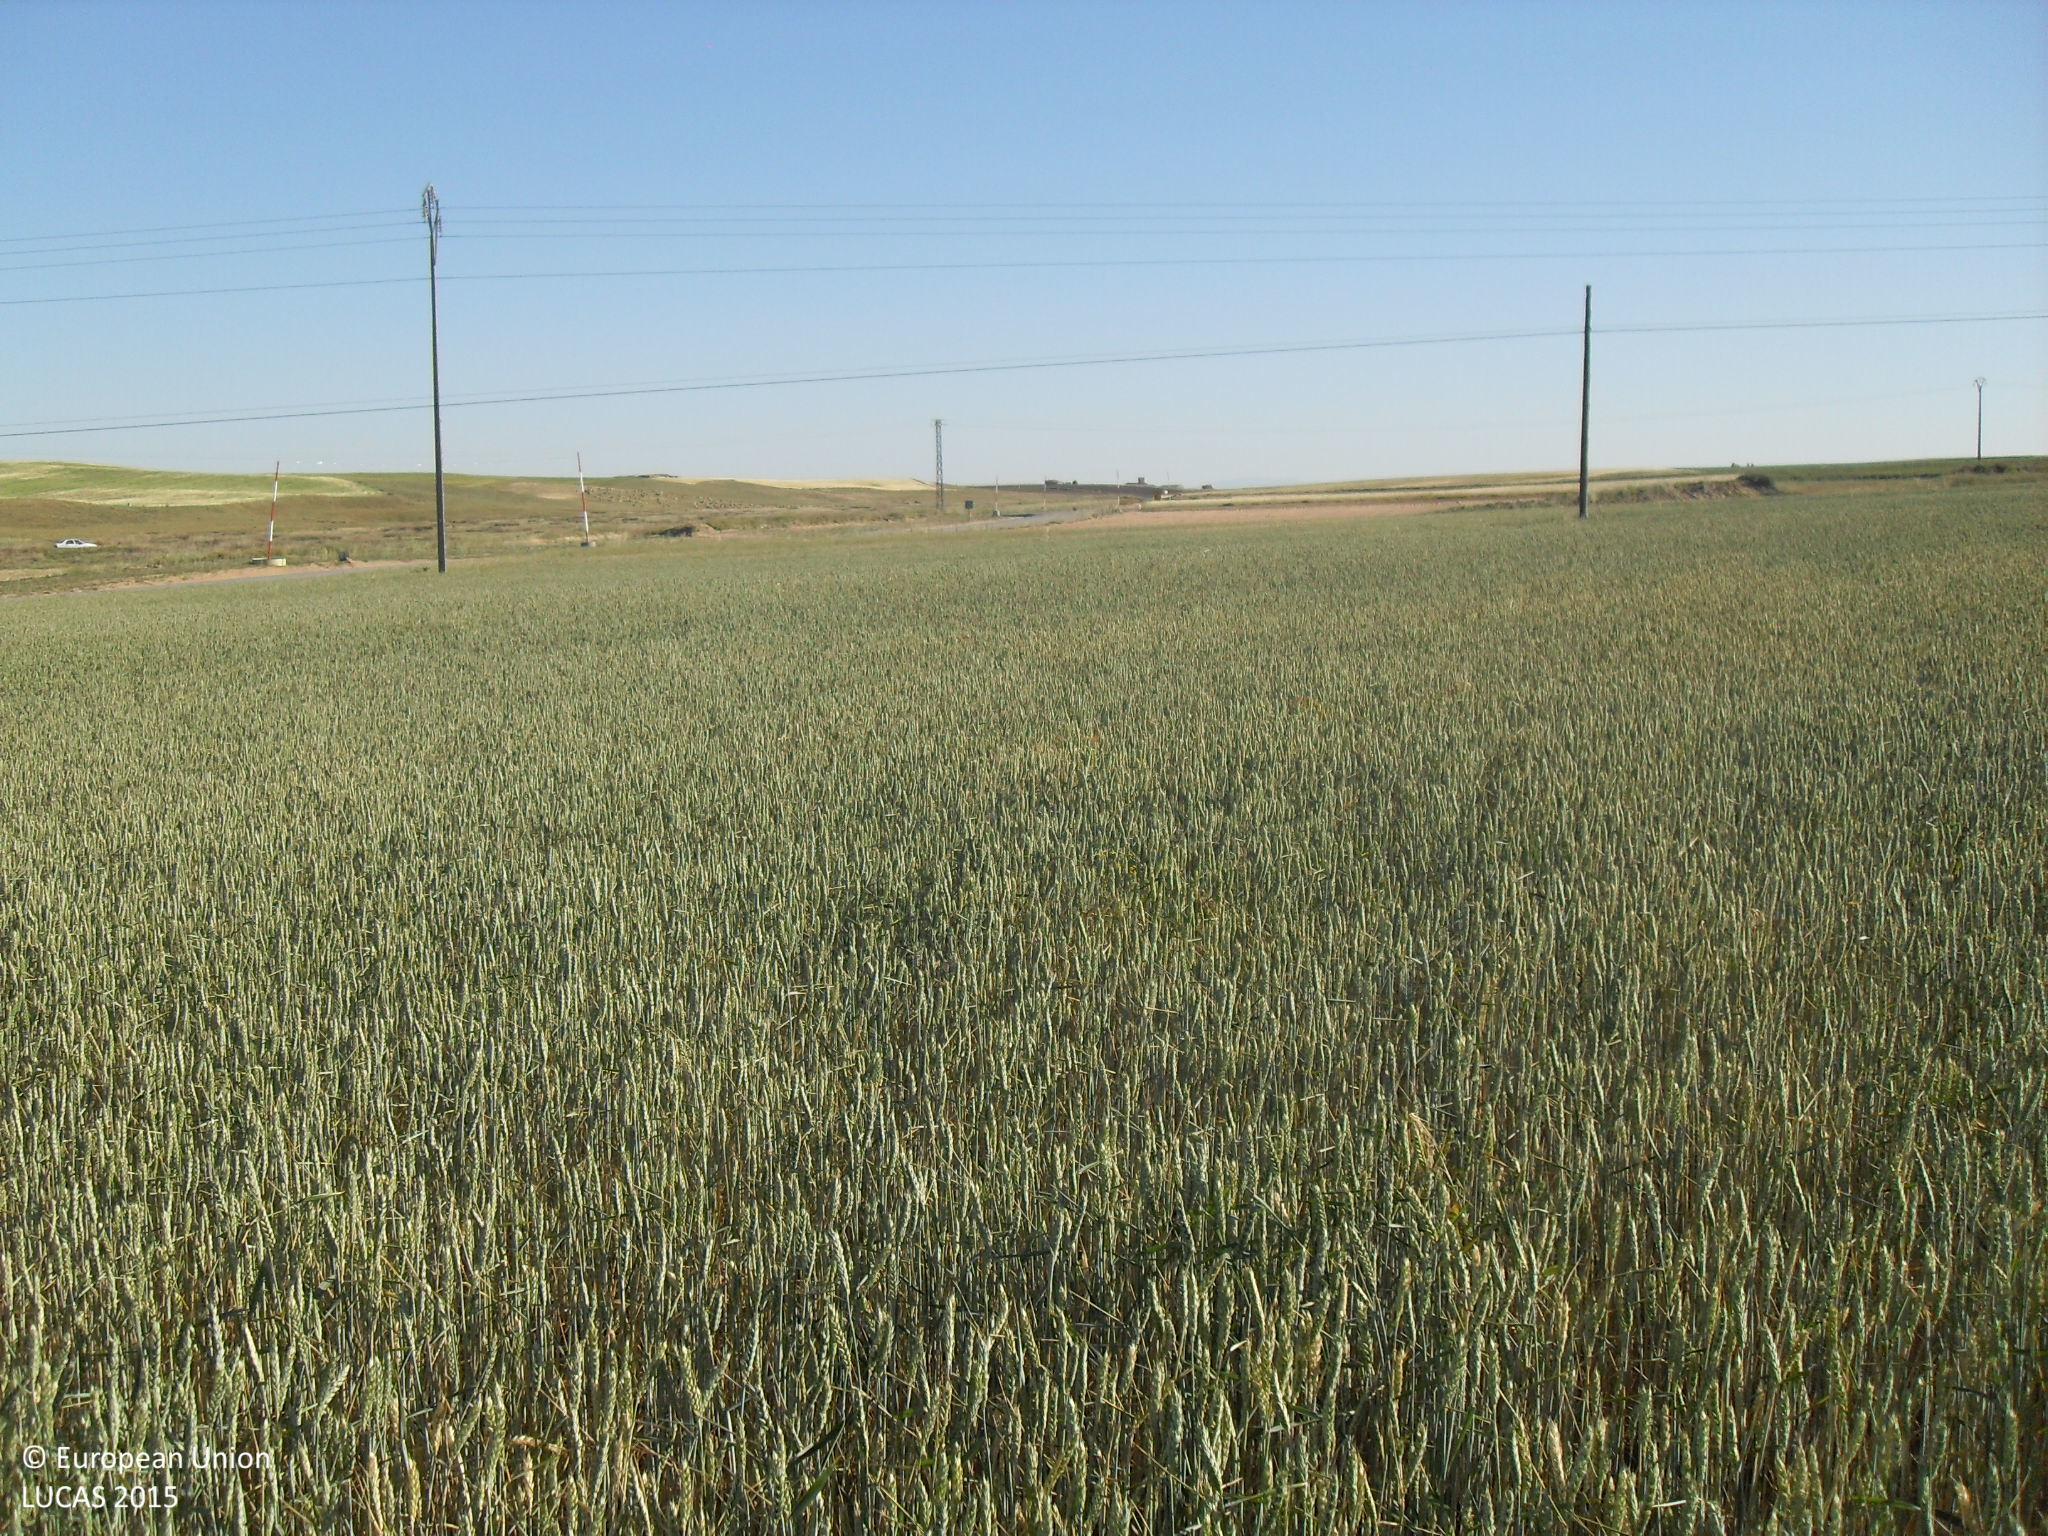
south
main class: Cropland
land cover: Common wheat
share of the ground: > 75 %
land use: Agriculture (excluding fallow land and kitchen gardens)
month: May
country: ES
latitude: 41.0452
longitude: -5.2869
